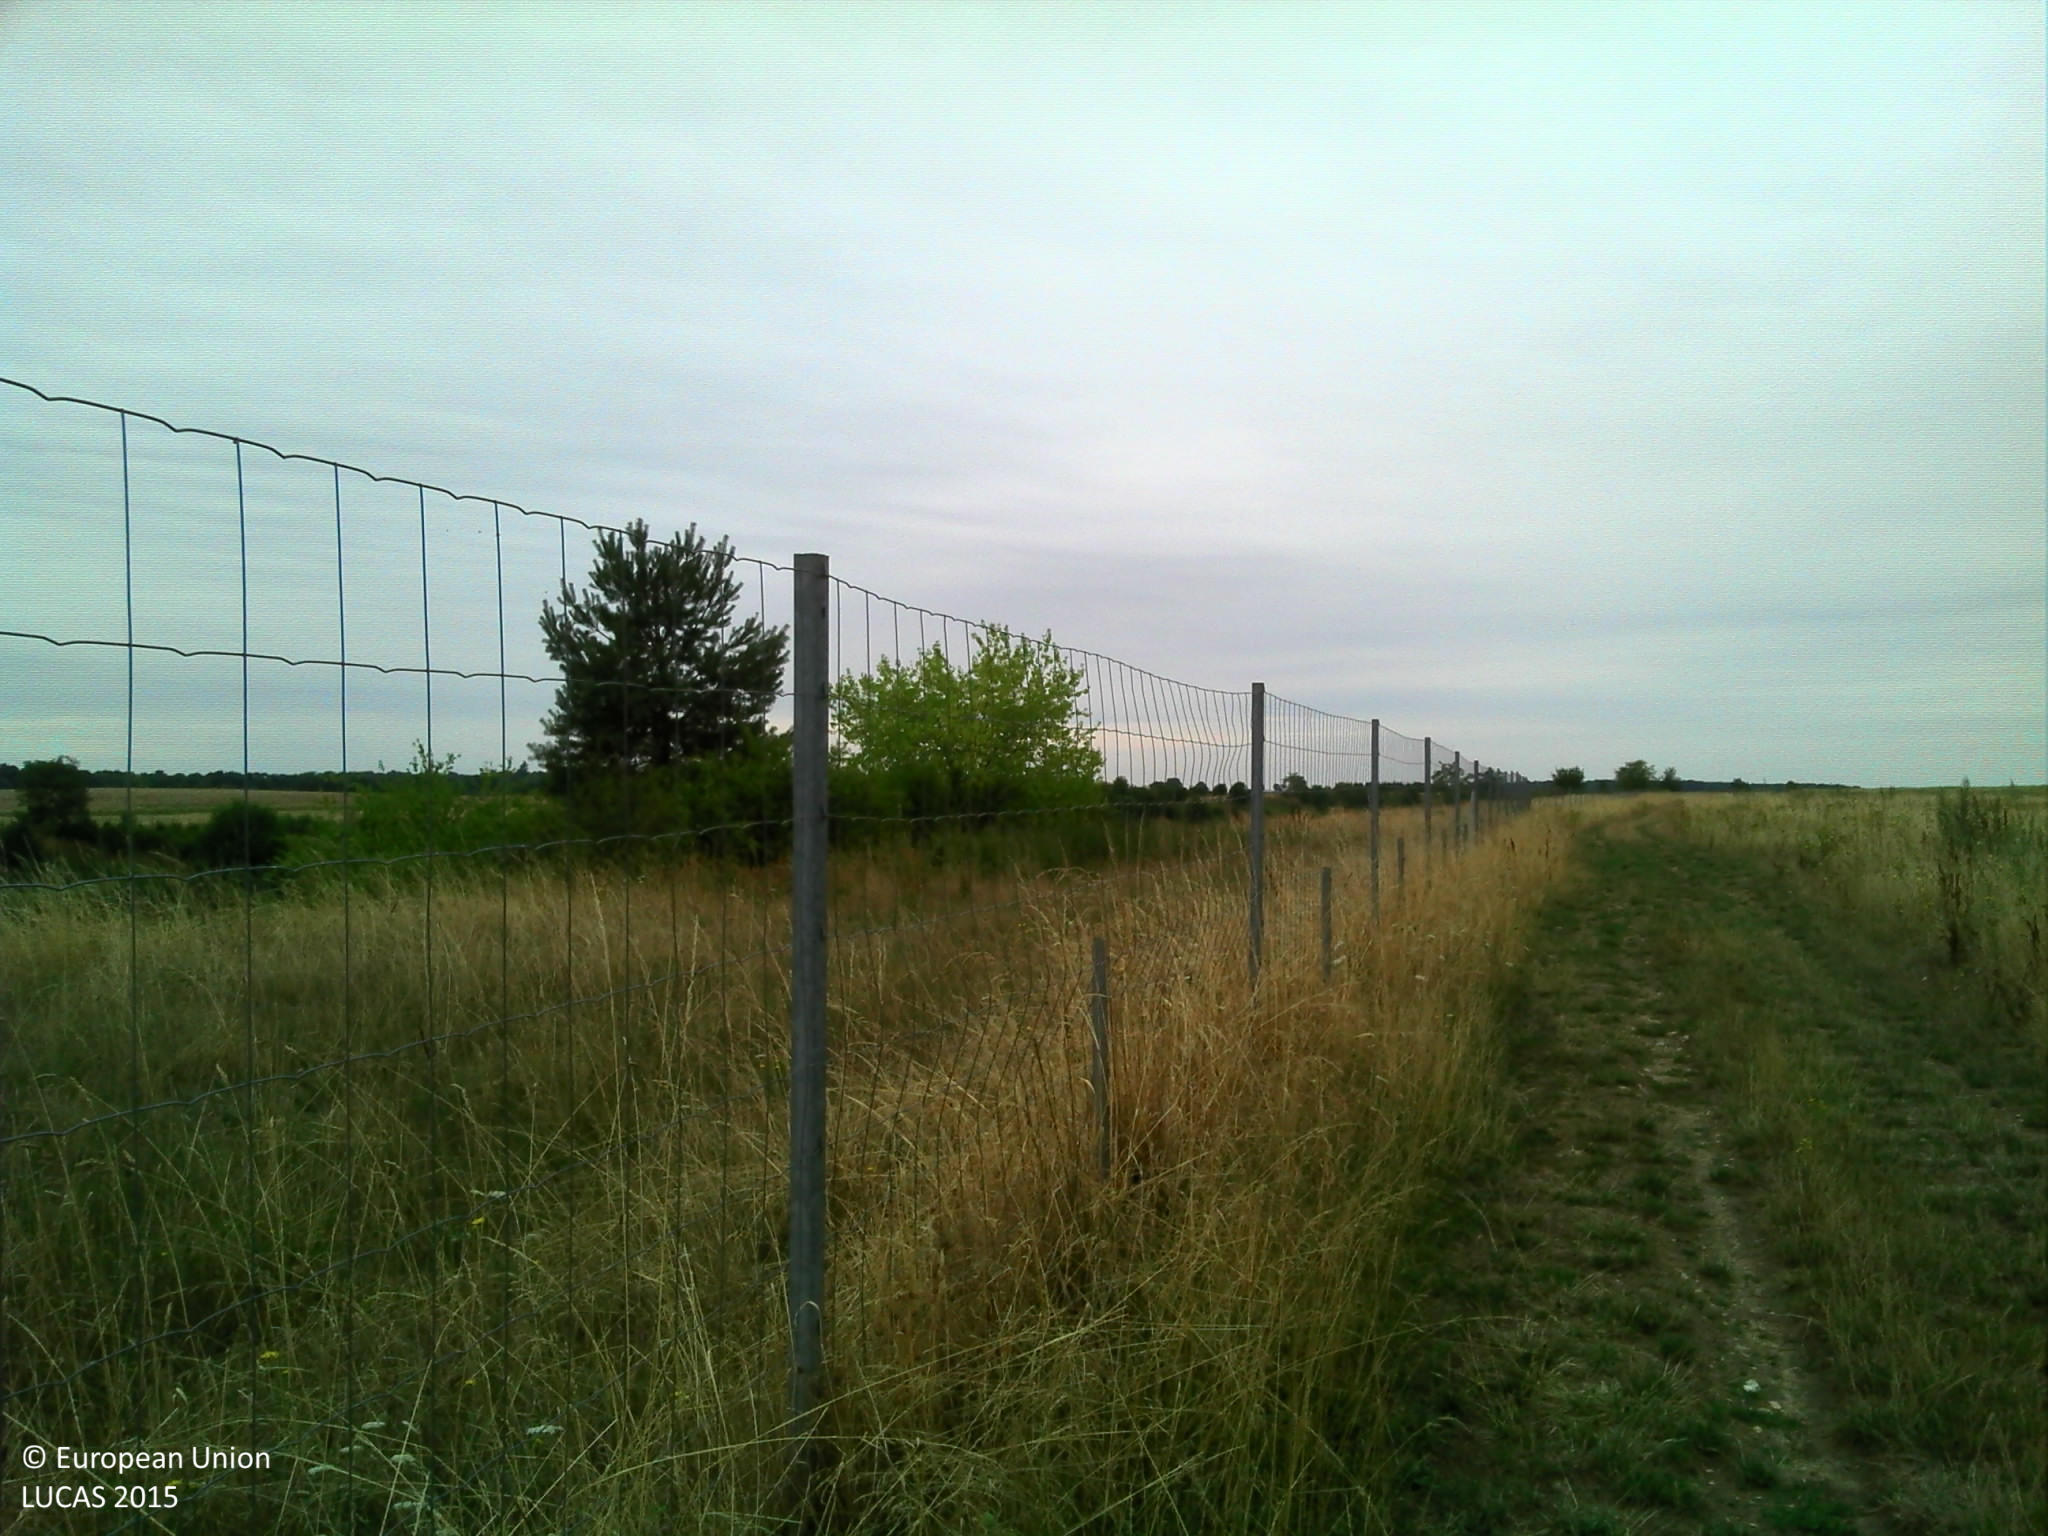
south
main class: Grassland
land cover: Grassland with sparse tree/shrub cover
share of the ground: > 75 %
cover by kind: herbaceous plants 95 %, broadleaved forest trees 5 %
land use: Semi-natural and natural areas not in use
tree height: < 5 m
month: August
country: FR
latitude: 48.1471
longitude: 2.7468
